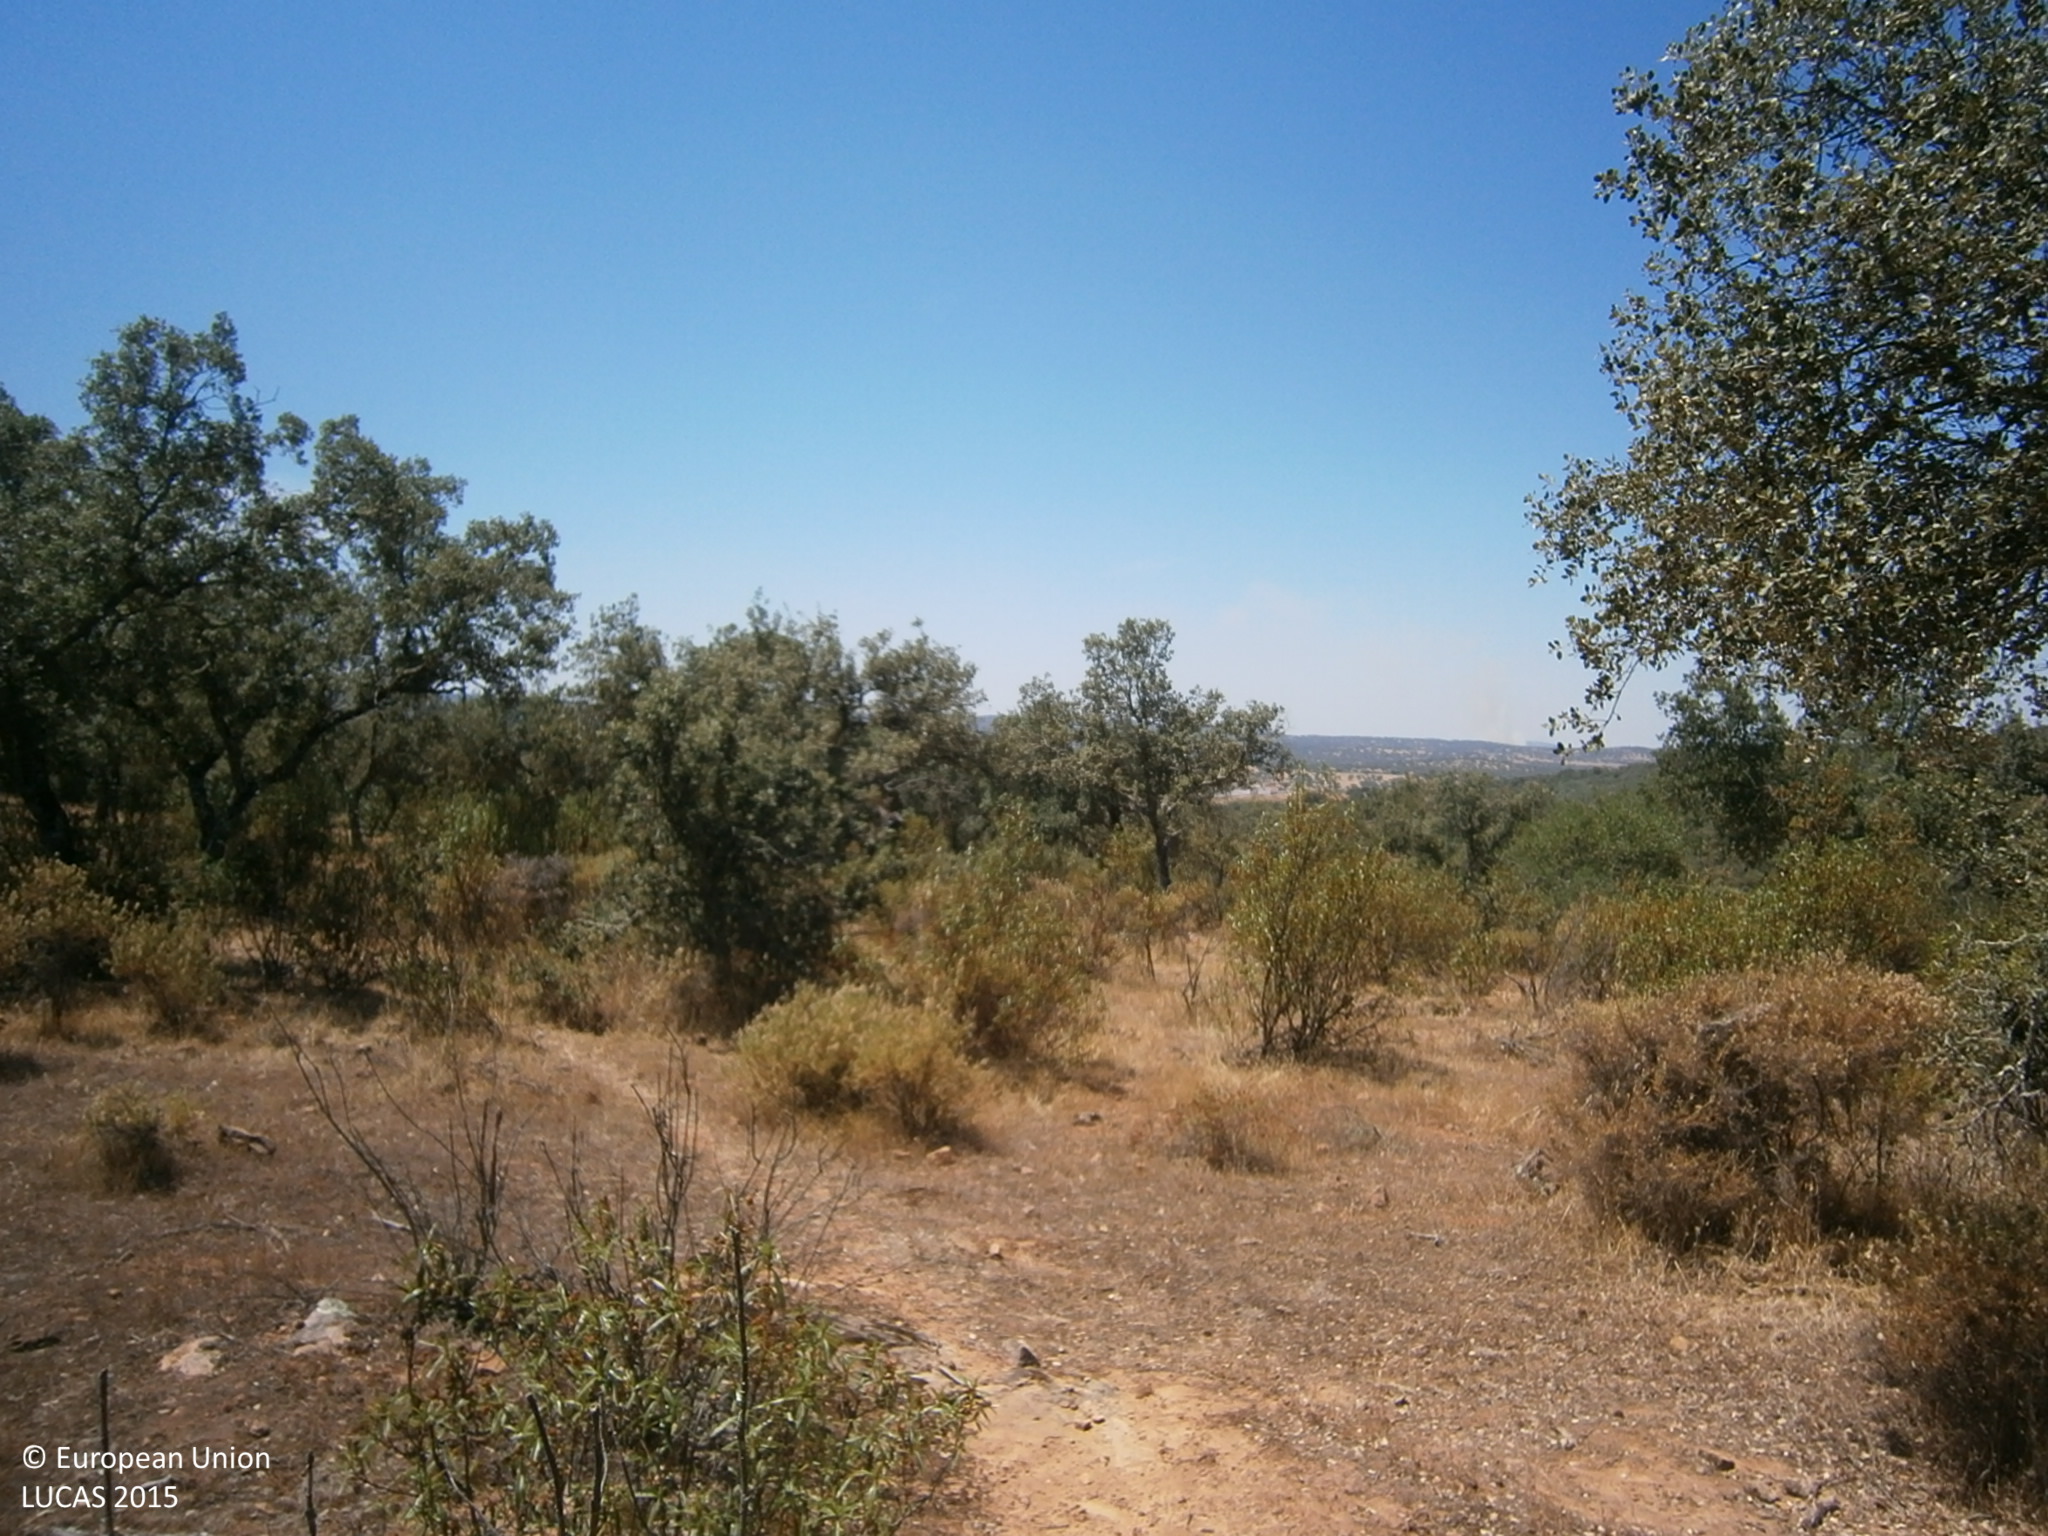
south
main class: Woodland
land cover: Broadleaved woodland
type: acidophilous oak and oak-birch forest
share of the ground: 25 - 50 %
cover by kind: broadleaved forest trees 40 %, herbaceous plants 25 %, shrubs 20 %, unconsolidated bare surface 15 %
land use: Agriculture (excluding fallow land and kitchen gardens)
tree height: > 5 m
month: June
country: ES
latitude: 38.5992
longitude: -6.9311
